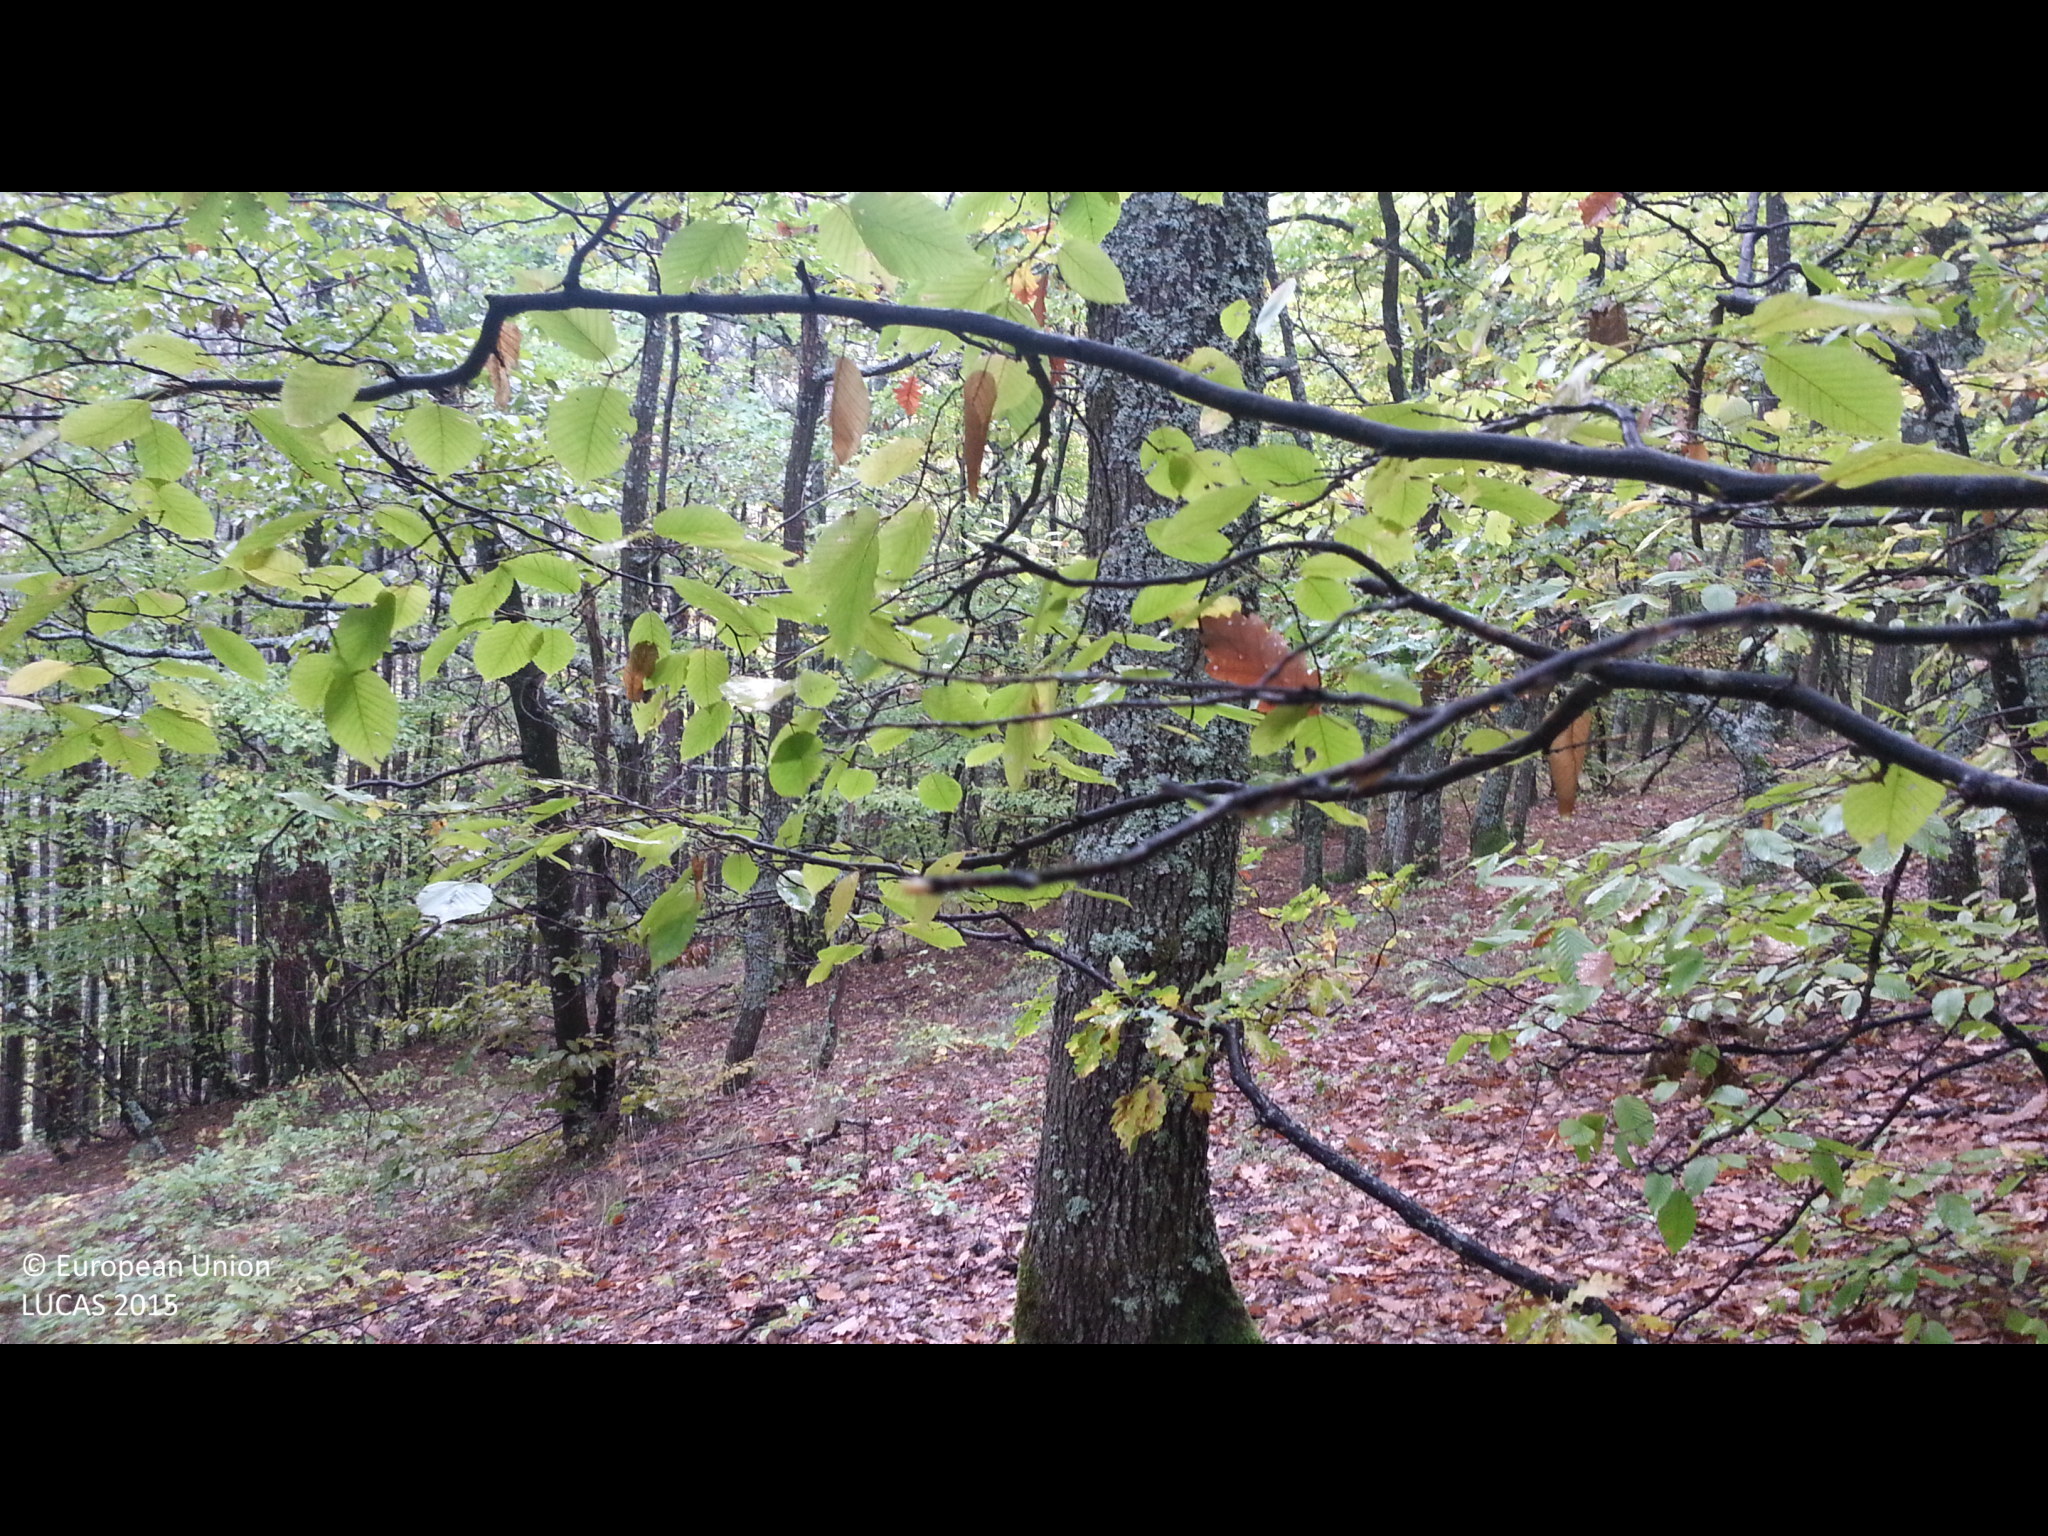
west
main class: Woodland
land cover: Broadleaved woodland
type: mesophytic deciduous forest
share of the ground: > 75 %
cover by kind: broadleaved forest trees 90 %, herbaceous plants 5 %, unconsolidated bare surface 5 %
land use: Forestry
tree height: > 5 m
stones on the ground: < 10 %
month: October
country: BG
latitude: 42.7432
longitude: 22.7189
